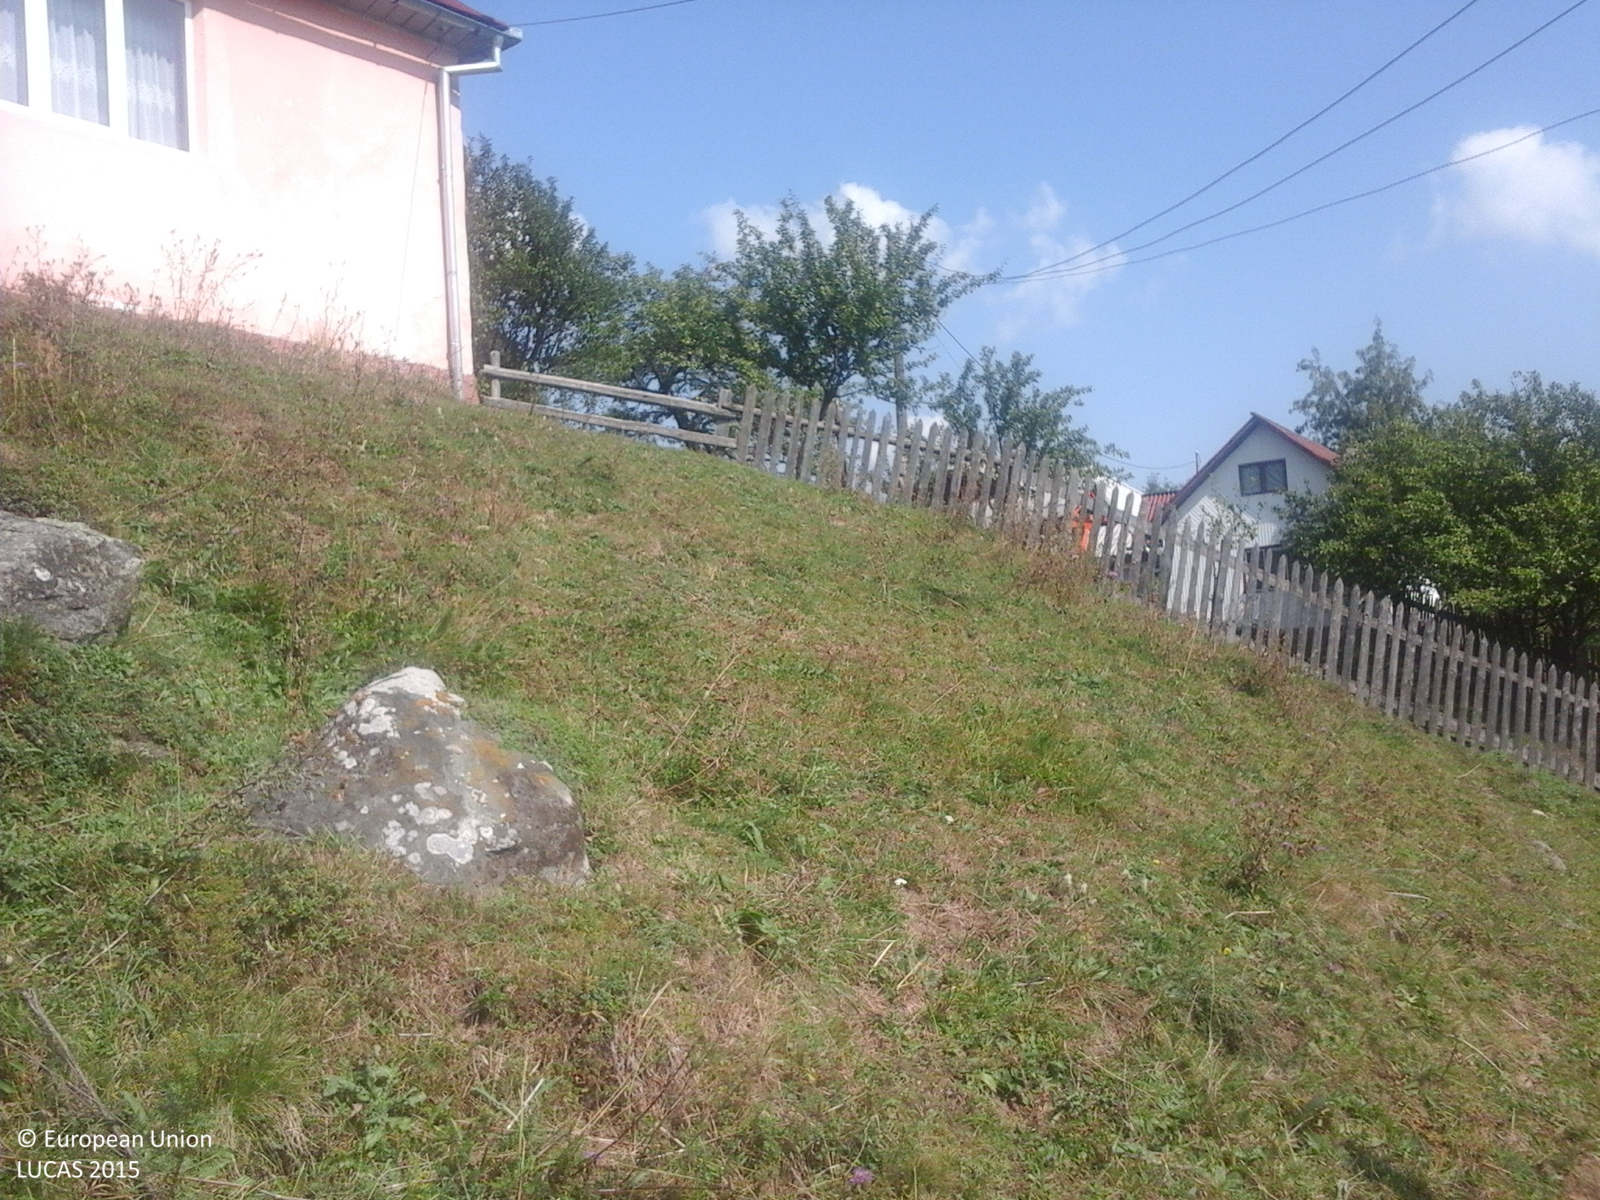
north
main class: Grassland
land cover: Grassland without tree/shrub cover
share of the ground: > 75 %
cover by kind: herbaceous plants 100 %
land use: Agriculture (excluding fallow land and kitchen gardens)
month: September
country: RO
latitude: 47.6373
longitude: 24.6723
